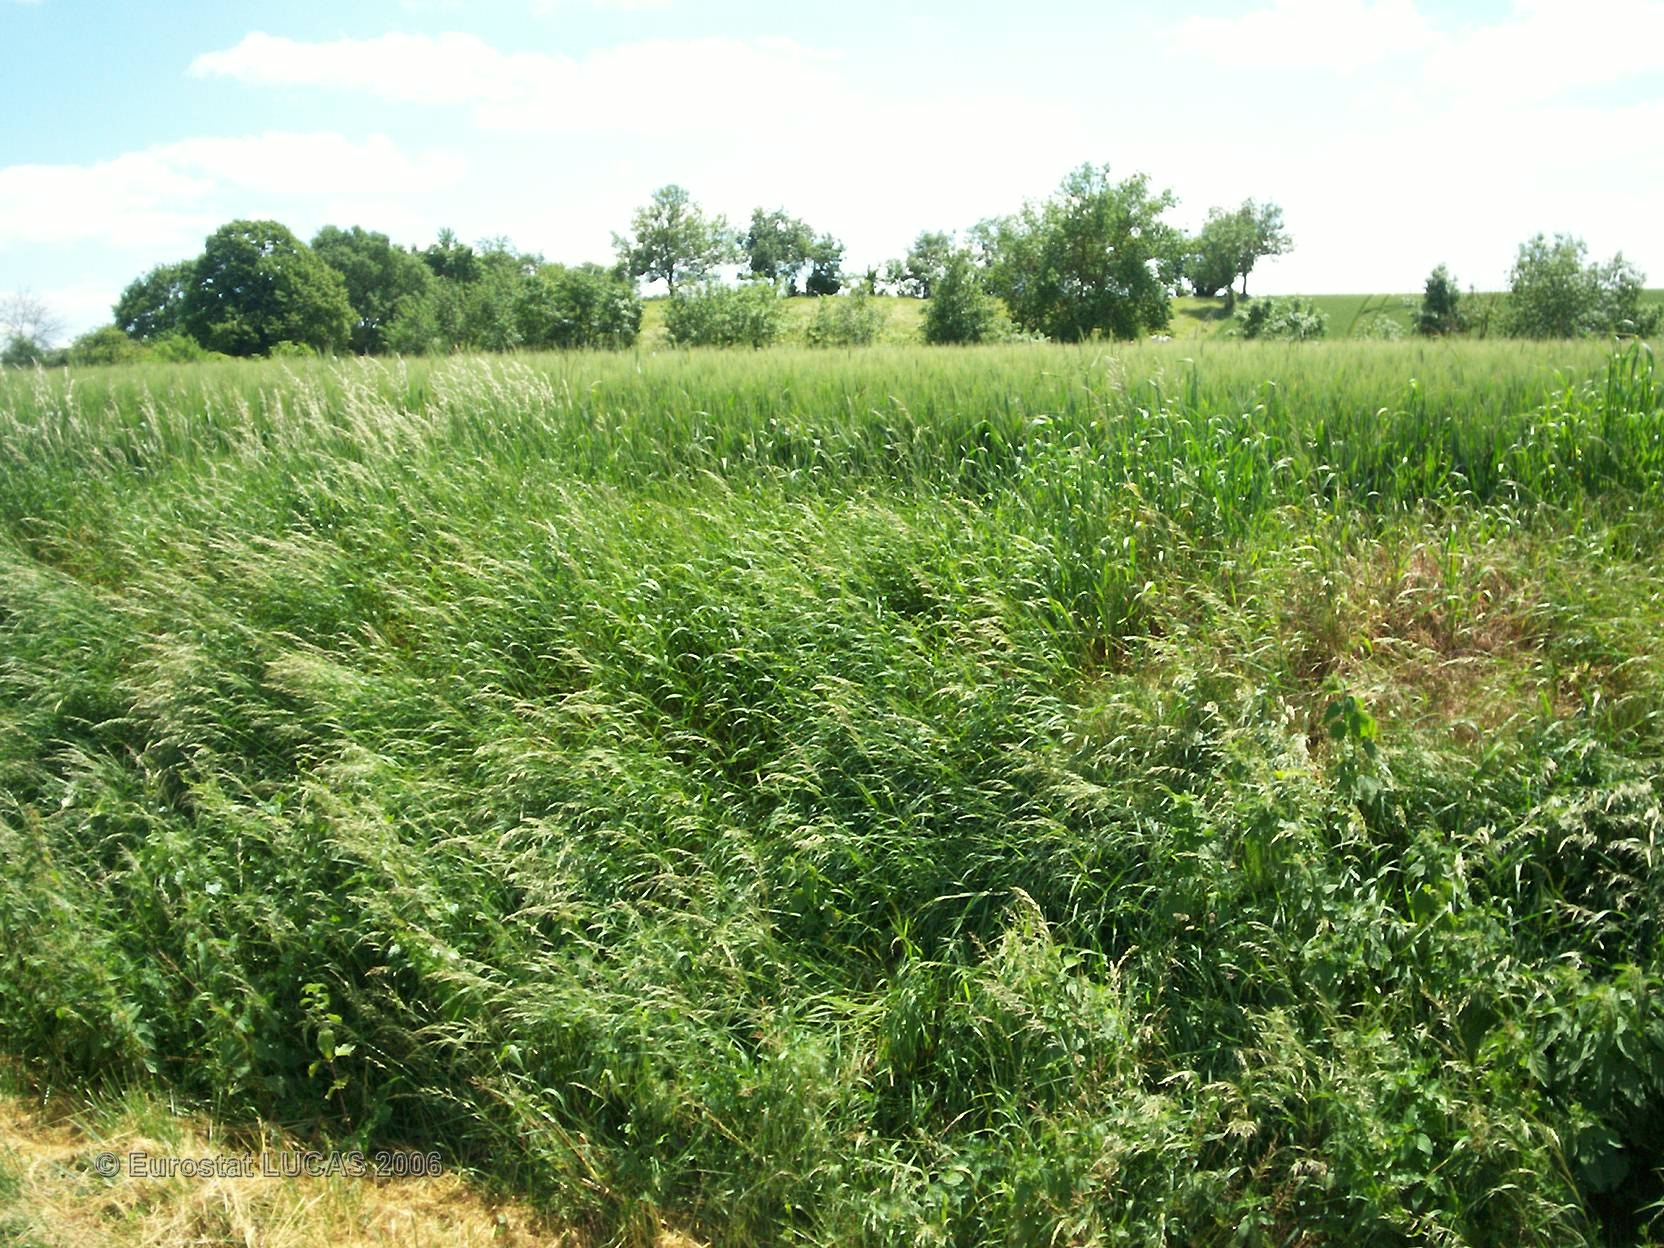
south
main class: Grassland
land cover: Grassland with sparse tree/shrub cover
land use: Residential
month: May
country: FR
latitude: 43.7208
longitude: 0.9754
